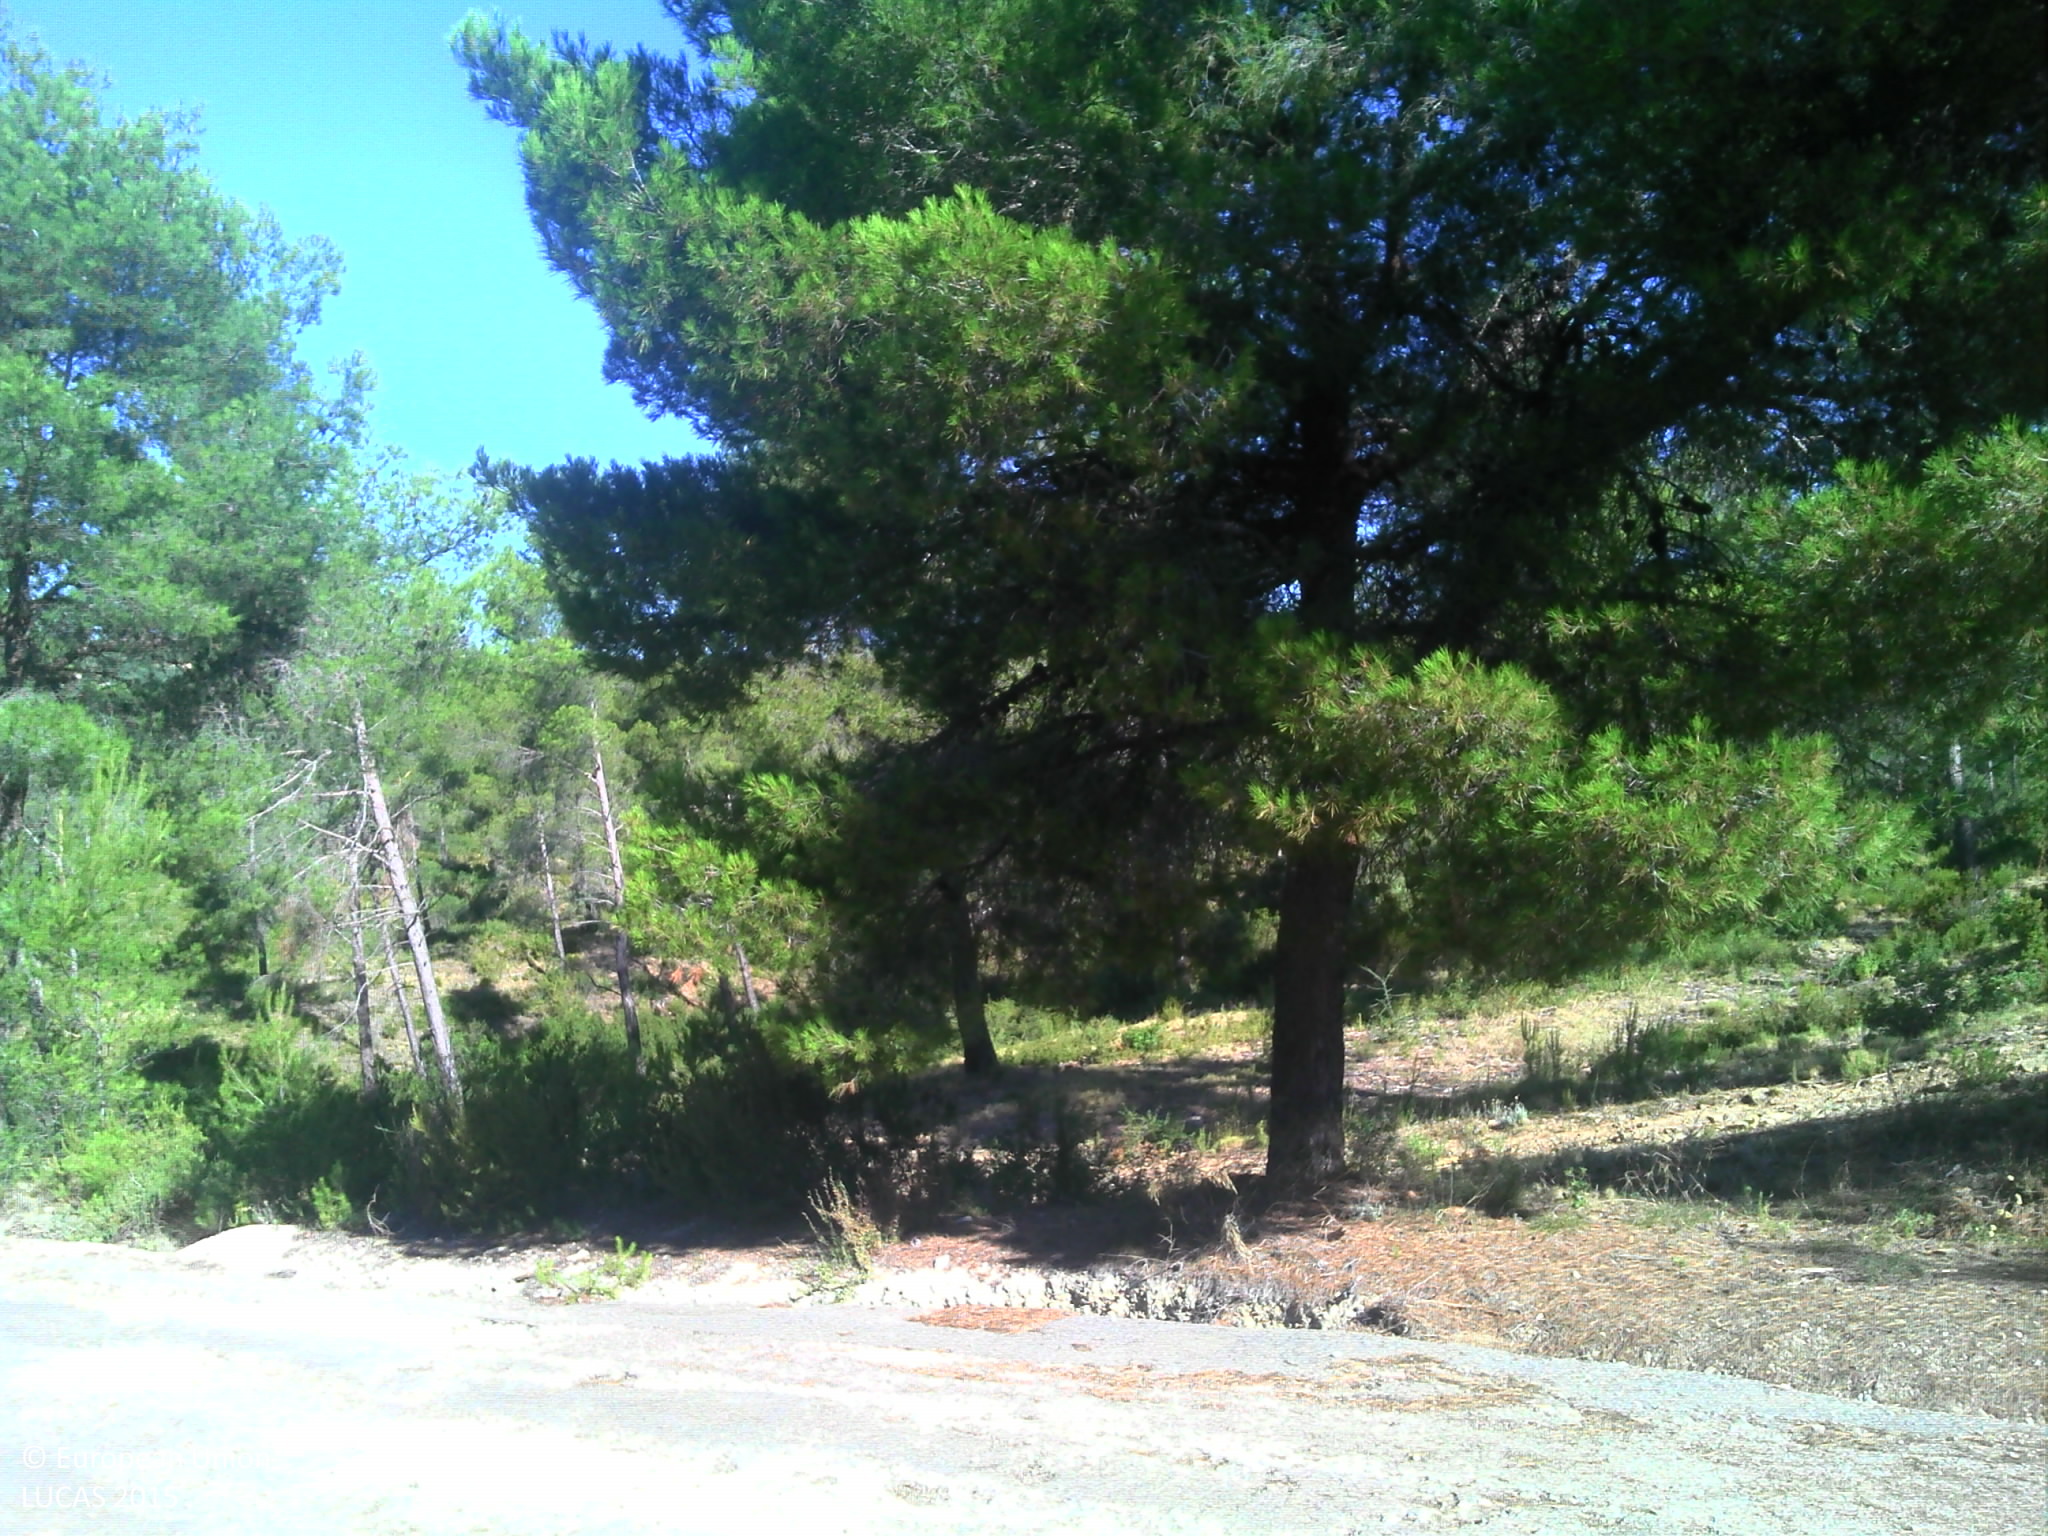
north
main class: Woodland
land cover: Pine dominated coniferous woodland
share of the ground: > 75 %
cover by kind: coniferous forest trees 35 %, herbaceous plants 30 %, consolidated bare surface 25 %, shrubs 10 %
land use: Road transport
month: August
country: FR
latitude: 43.1941
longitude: 5.6666
